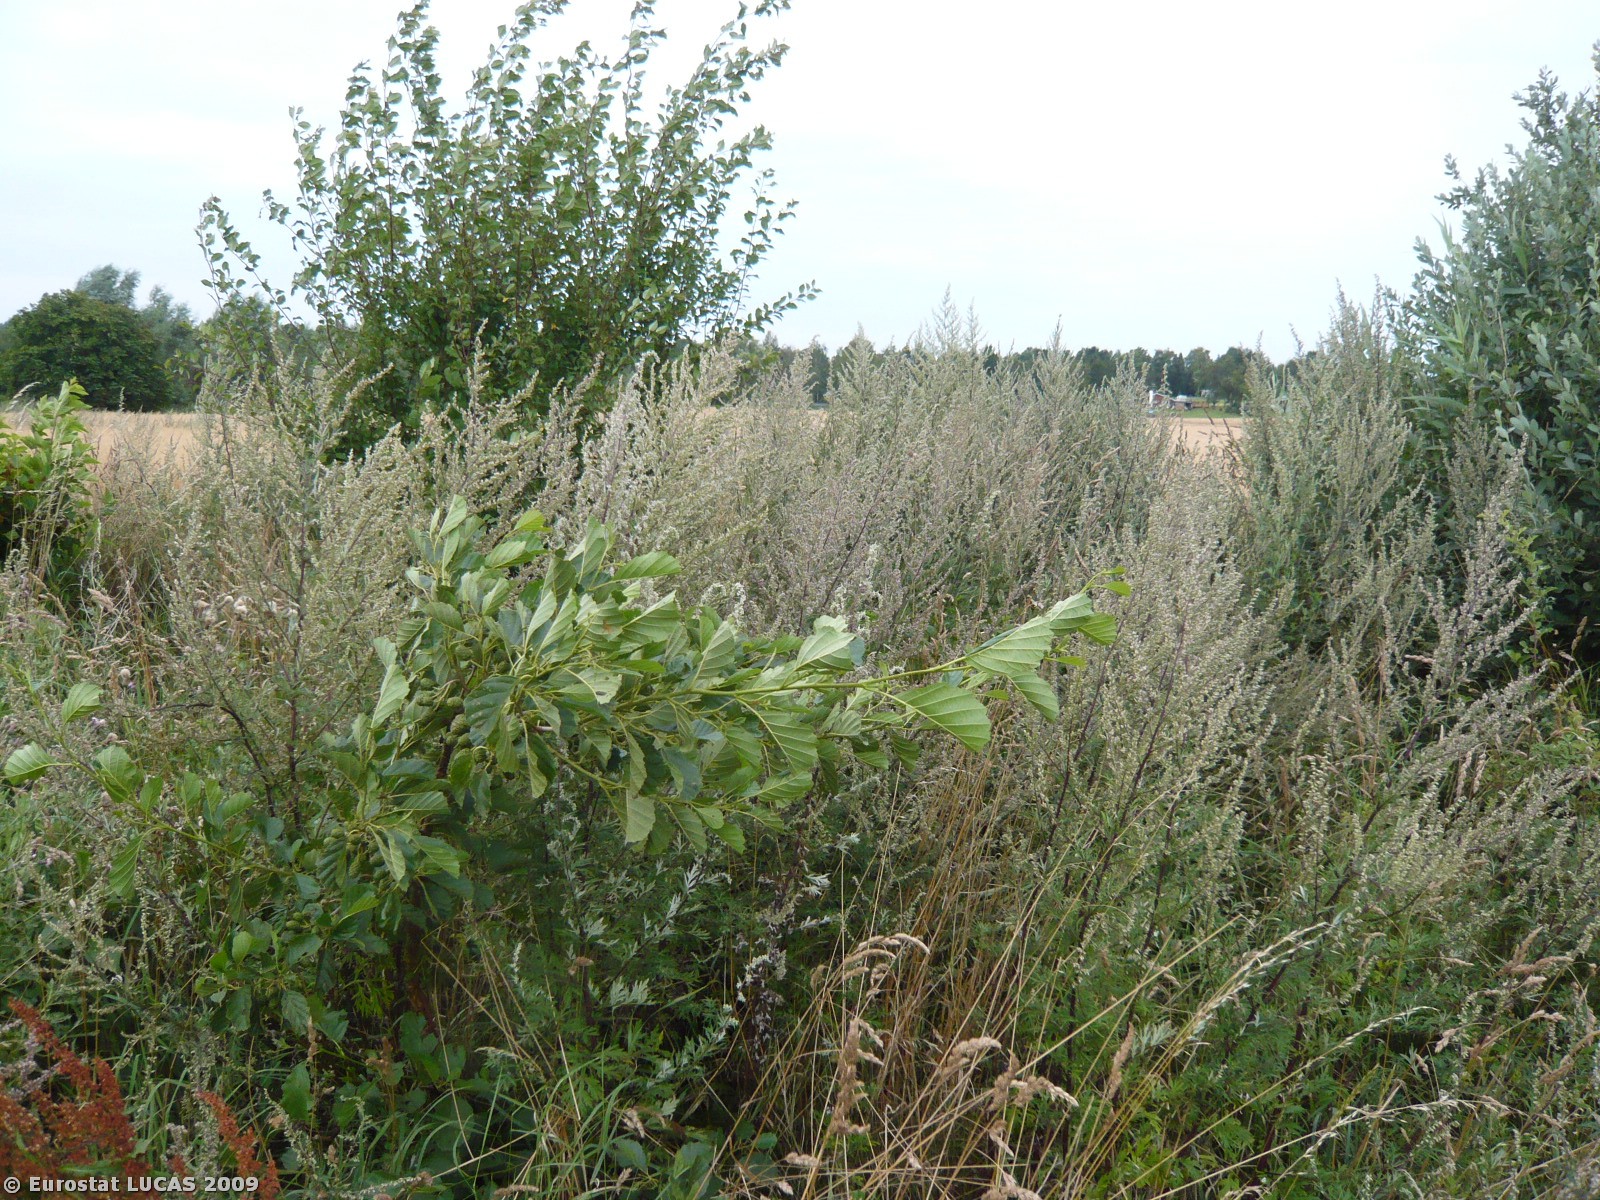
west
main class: Grassland
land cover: Grassland without tree/shrub cover
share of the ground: > 75 %
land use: Agriculture (excluding fallow land and kitchen gardens)
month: August
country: DK
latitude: 55.9923
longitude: 12.0020
